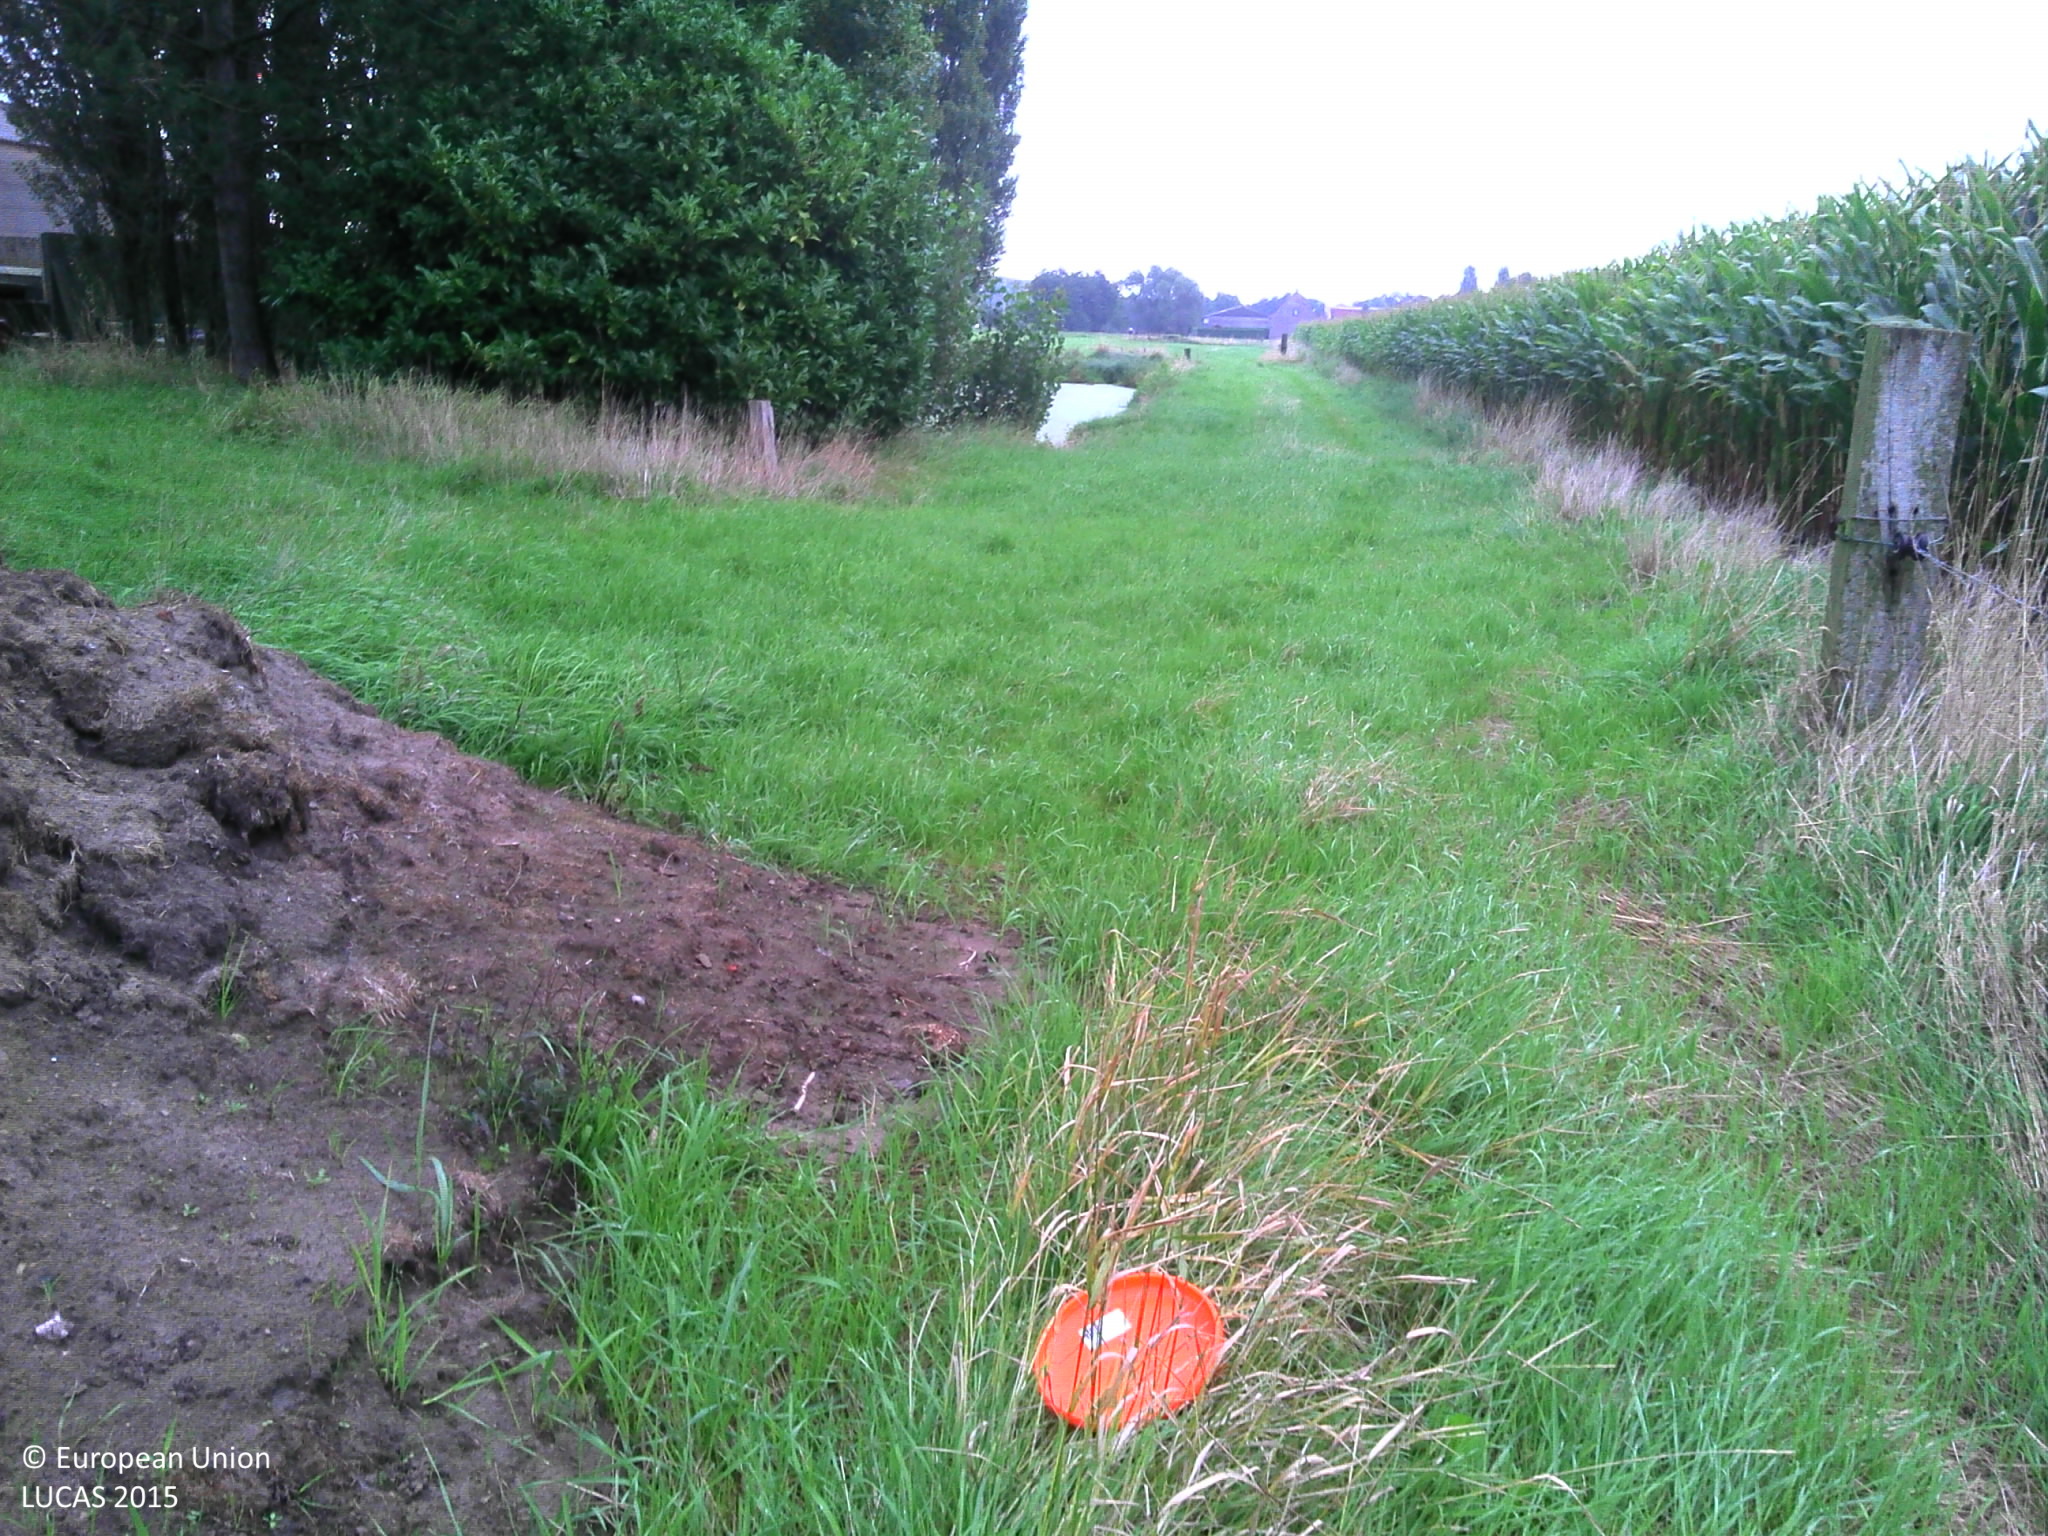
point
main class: Grassland
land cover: Grassland without tree/shrub cover
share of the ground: > 75 %
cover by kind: herbaceous plants 100 %
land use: Agriculture (excluding fallow land and kitchen gardens)
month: September
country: BE
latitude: 50.9866
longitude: 3.4246
